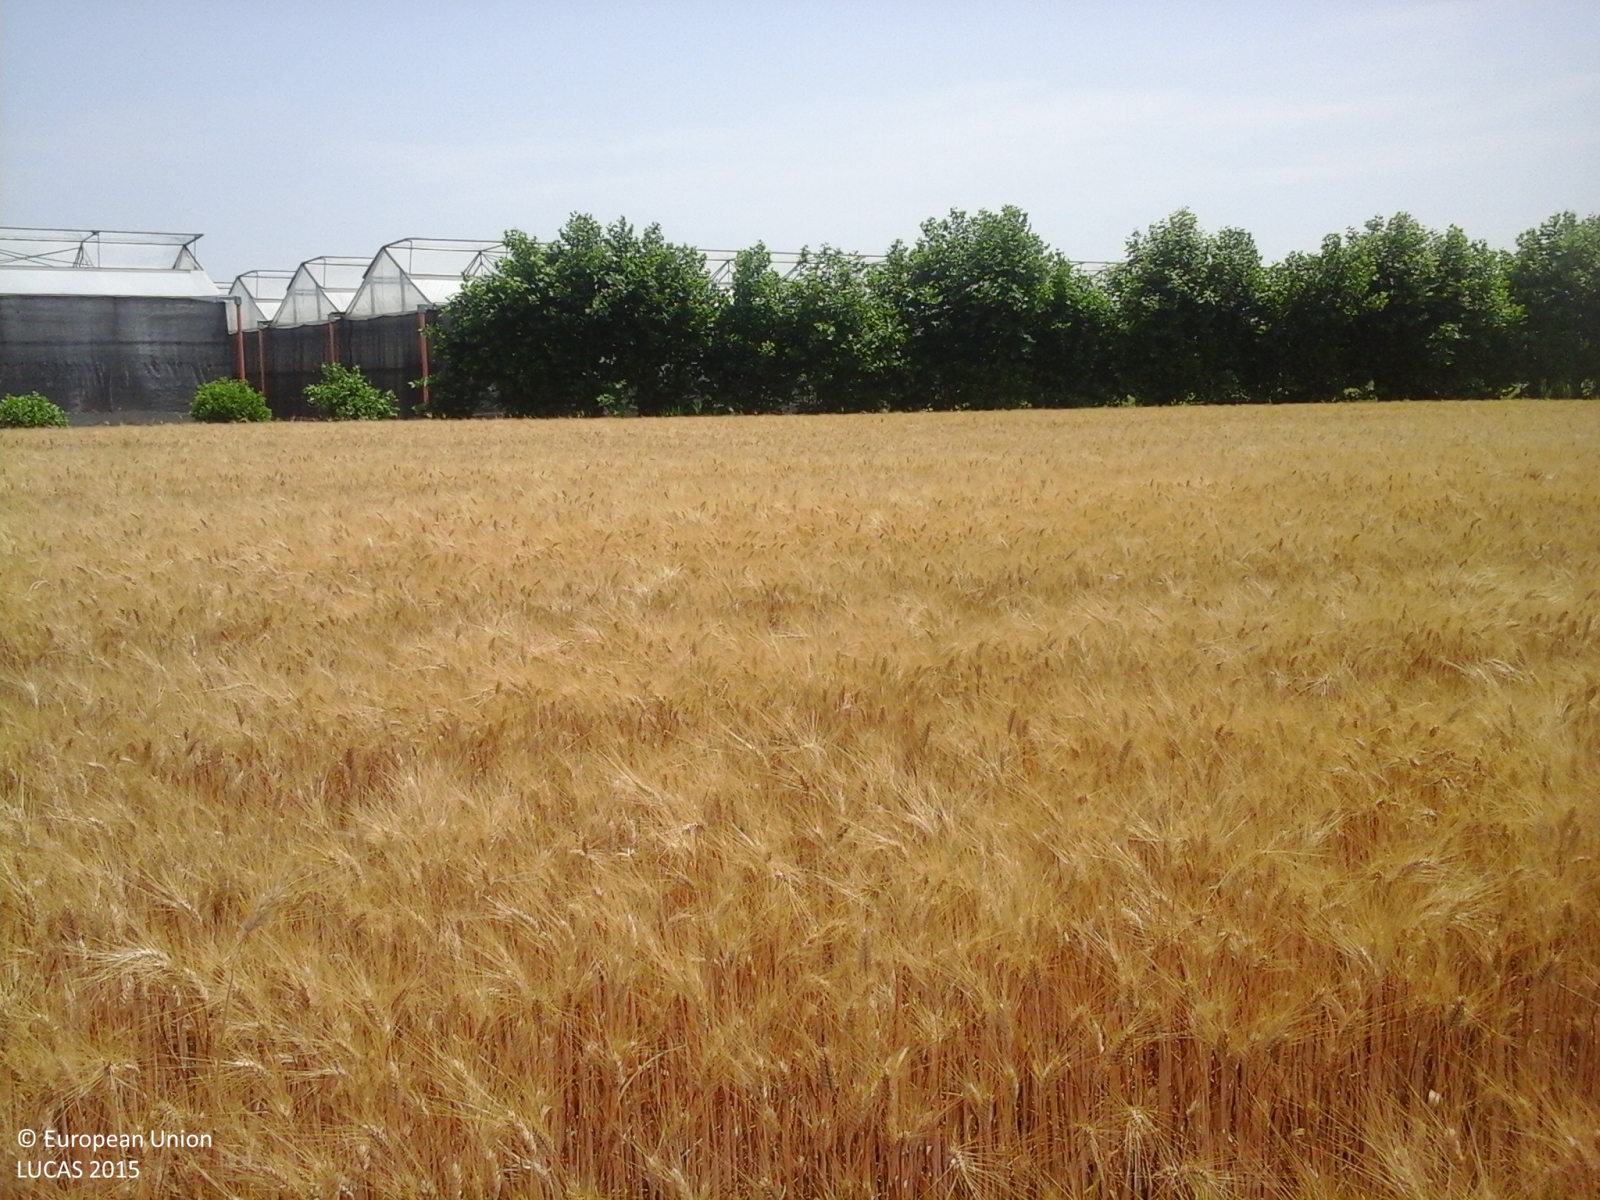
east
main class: Cropland
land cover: Durum wheat
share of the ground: > 75 %
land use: Agriculture (excluding fallow land and kitchen gardens)
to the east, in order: Durum wheat; Grassland without tree/shrub cover; Ditches and canals; Managed hedges; Artificial constructions in urban areas
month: June
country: IT
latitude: 45.2651
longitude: 11.0305
